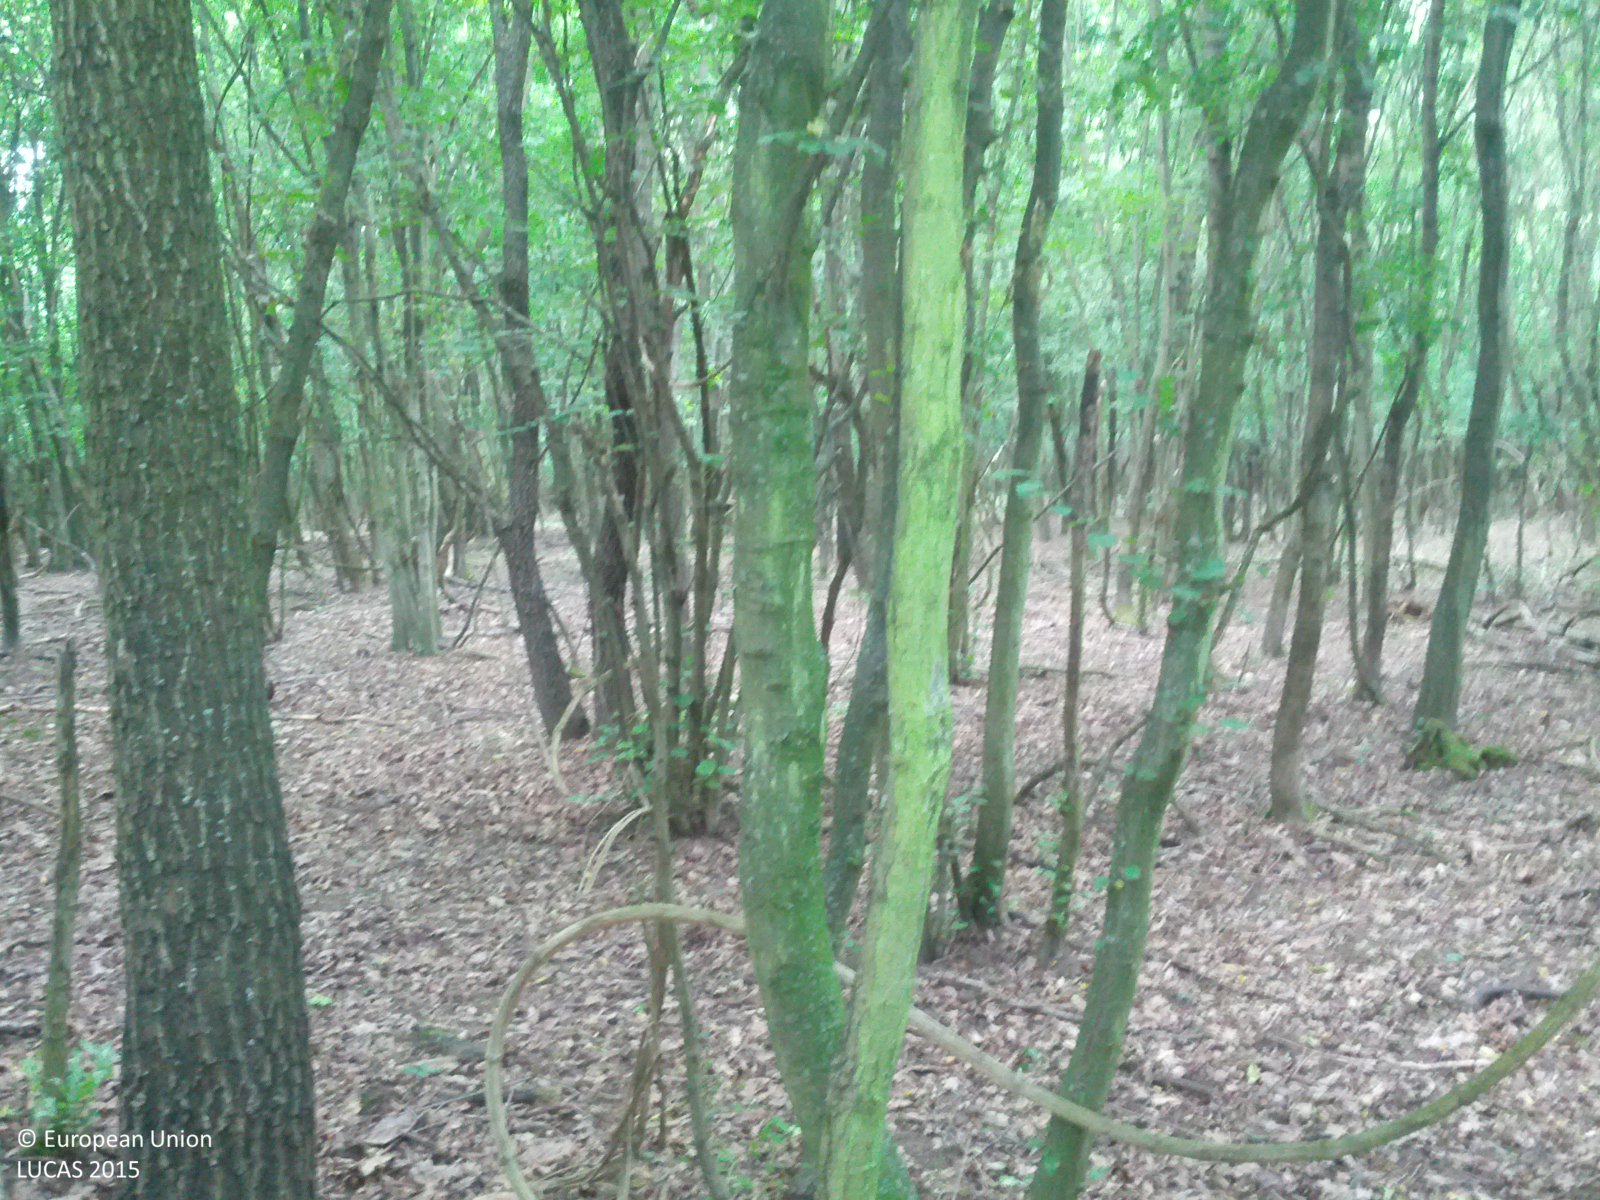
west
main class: Woodland
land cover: Broadleaved woodland
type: beech forest
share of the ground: > 75 %
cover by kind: broadleaved forest trees 95 %, herbaceous plants 5 %
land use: Forestry
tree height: > 5 m
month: June
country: AT
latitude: 48.4334
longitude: 16.7243
